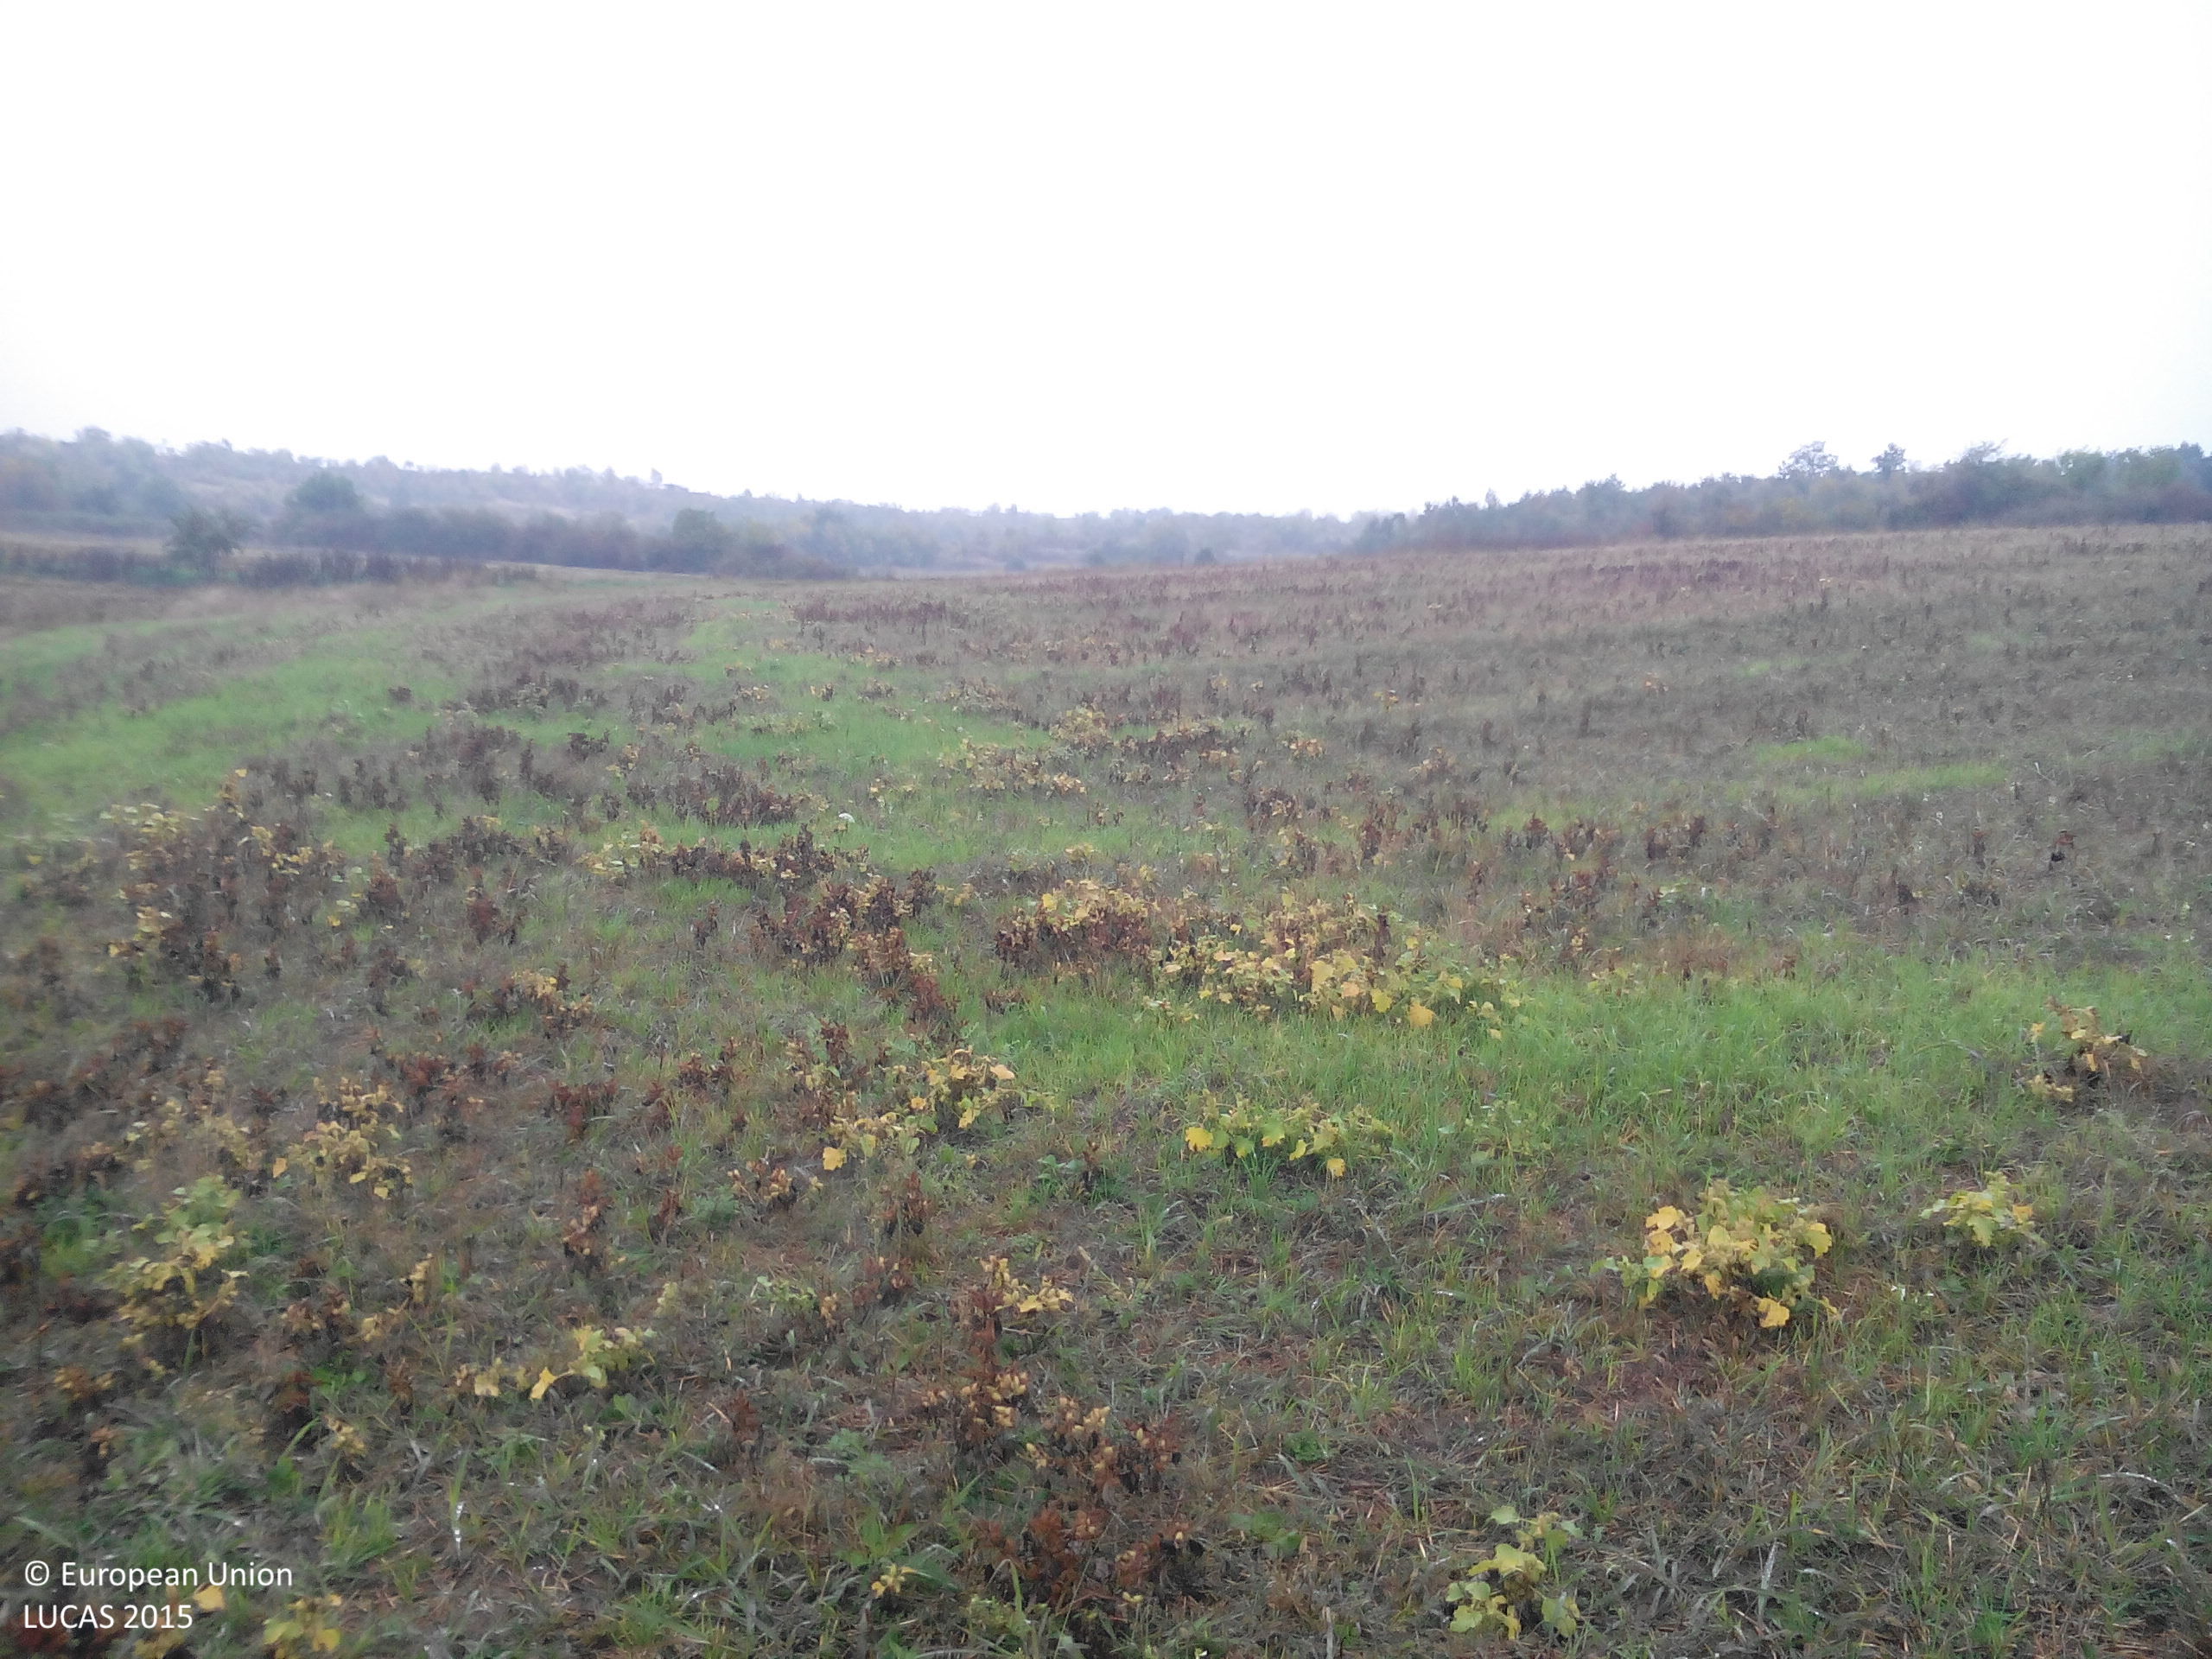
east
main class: Grassland
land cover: Grassland without tree/shrub cover
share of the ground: > 75 %
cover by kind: herbaceous plants 95 %, shrubs 5 %
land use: Agriculture (excluding fallow land and kitchen gardens)
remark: Harvested field
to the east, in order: Grassland without tree/shrub cover; Tracks; Grassland without tree/shrub cover; Shrubland with sparse tree cover
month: October
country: BG
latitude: 43.1724
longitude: 24.1617
